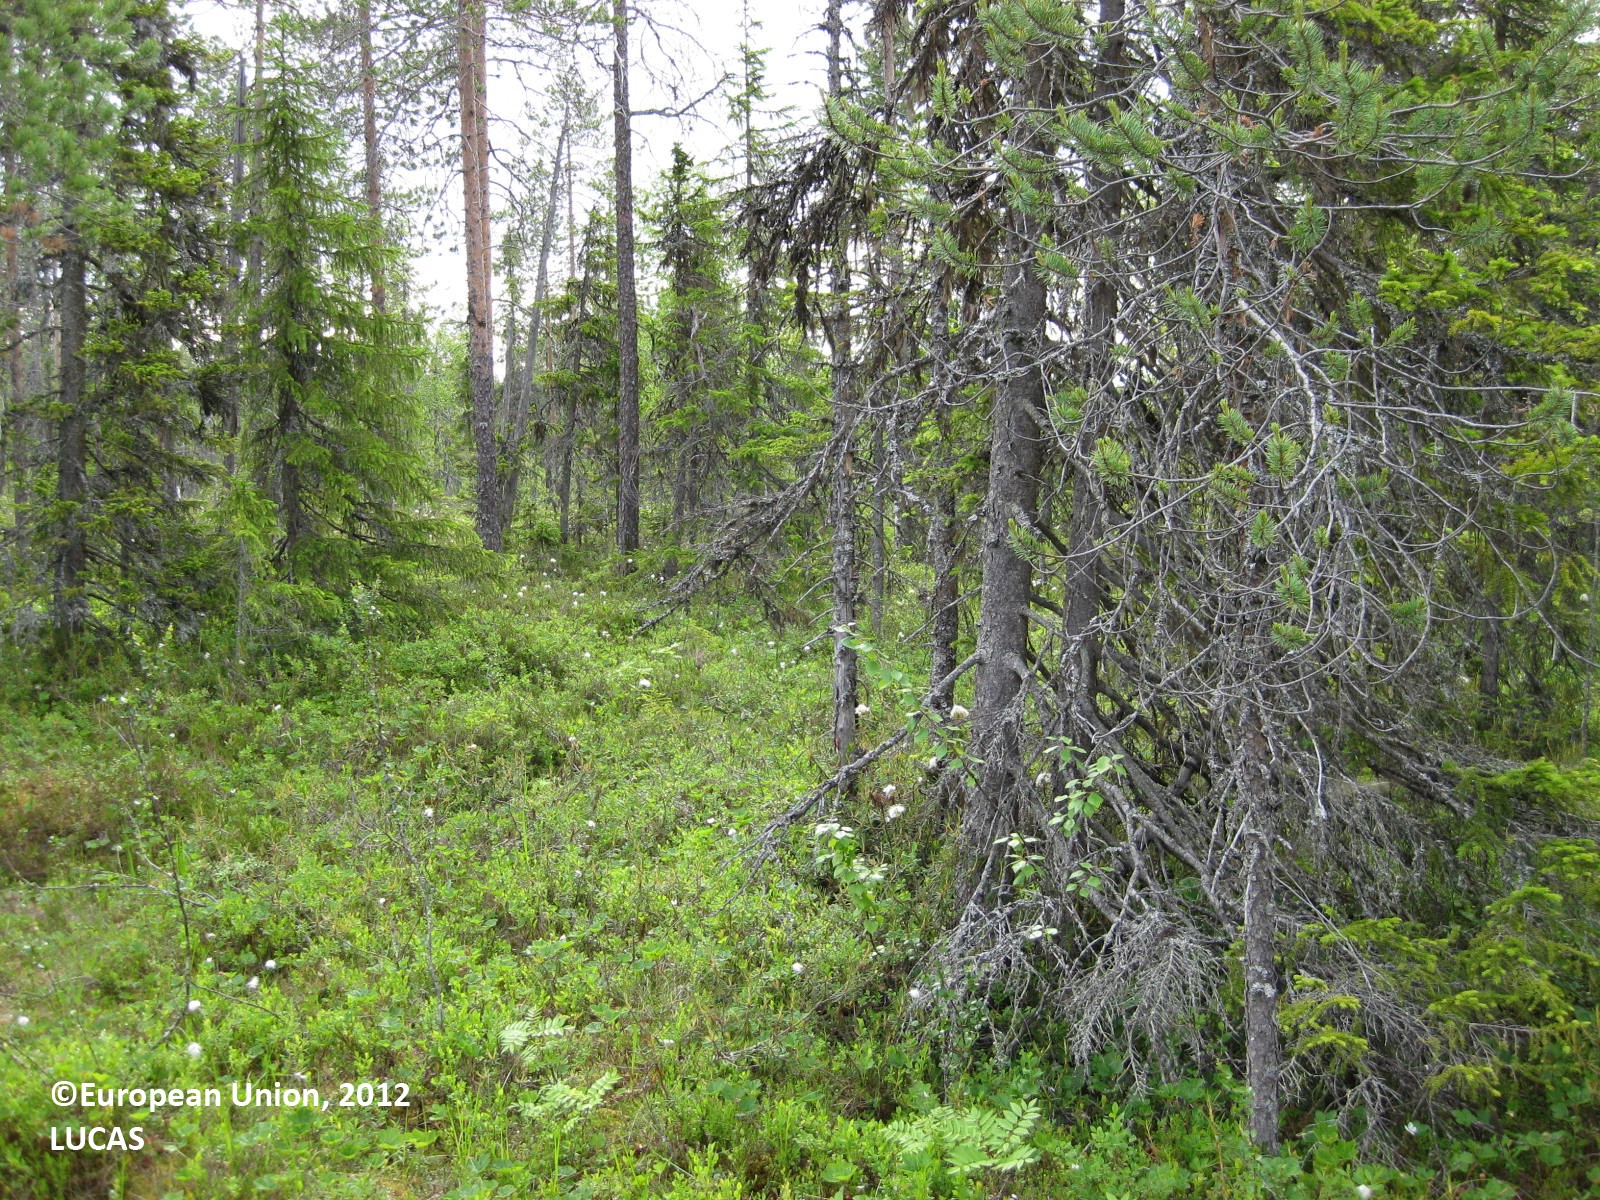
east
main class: Woodland
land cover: Other coniferous woodland
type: mire and swamp forests
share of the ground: 25 - 50 %
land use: Forestry
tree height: > 5 m
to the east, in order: Other coniferous woodland; Ditches and canals; Other coniferous woodland; Ditches and canals; Other coniferous woodland; Ditches and canals; Other coniferous woodland; Pine dominated coniferous woodland
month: July
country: FI
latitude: 65.5865
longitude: 29.2015
